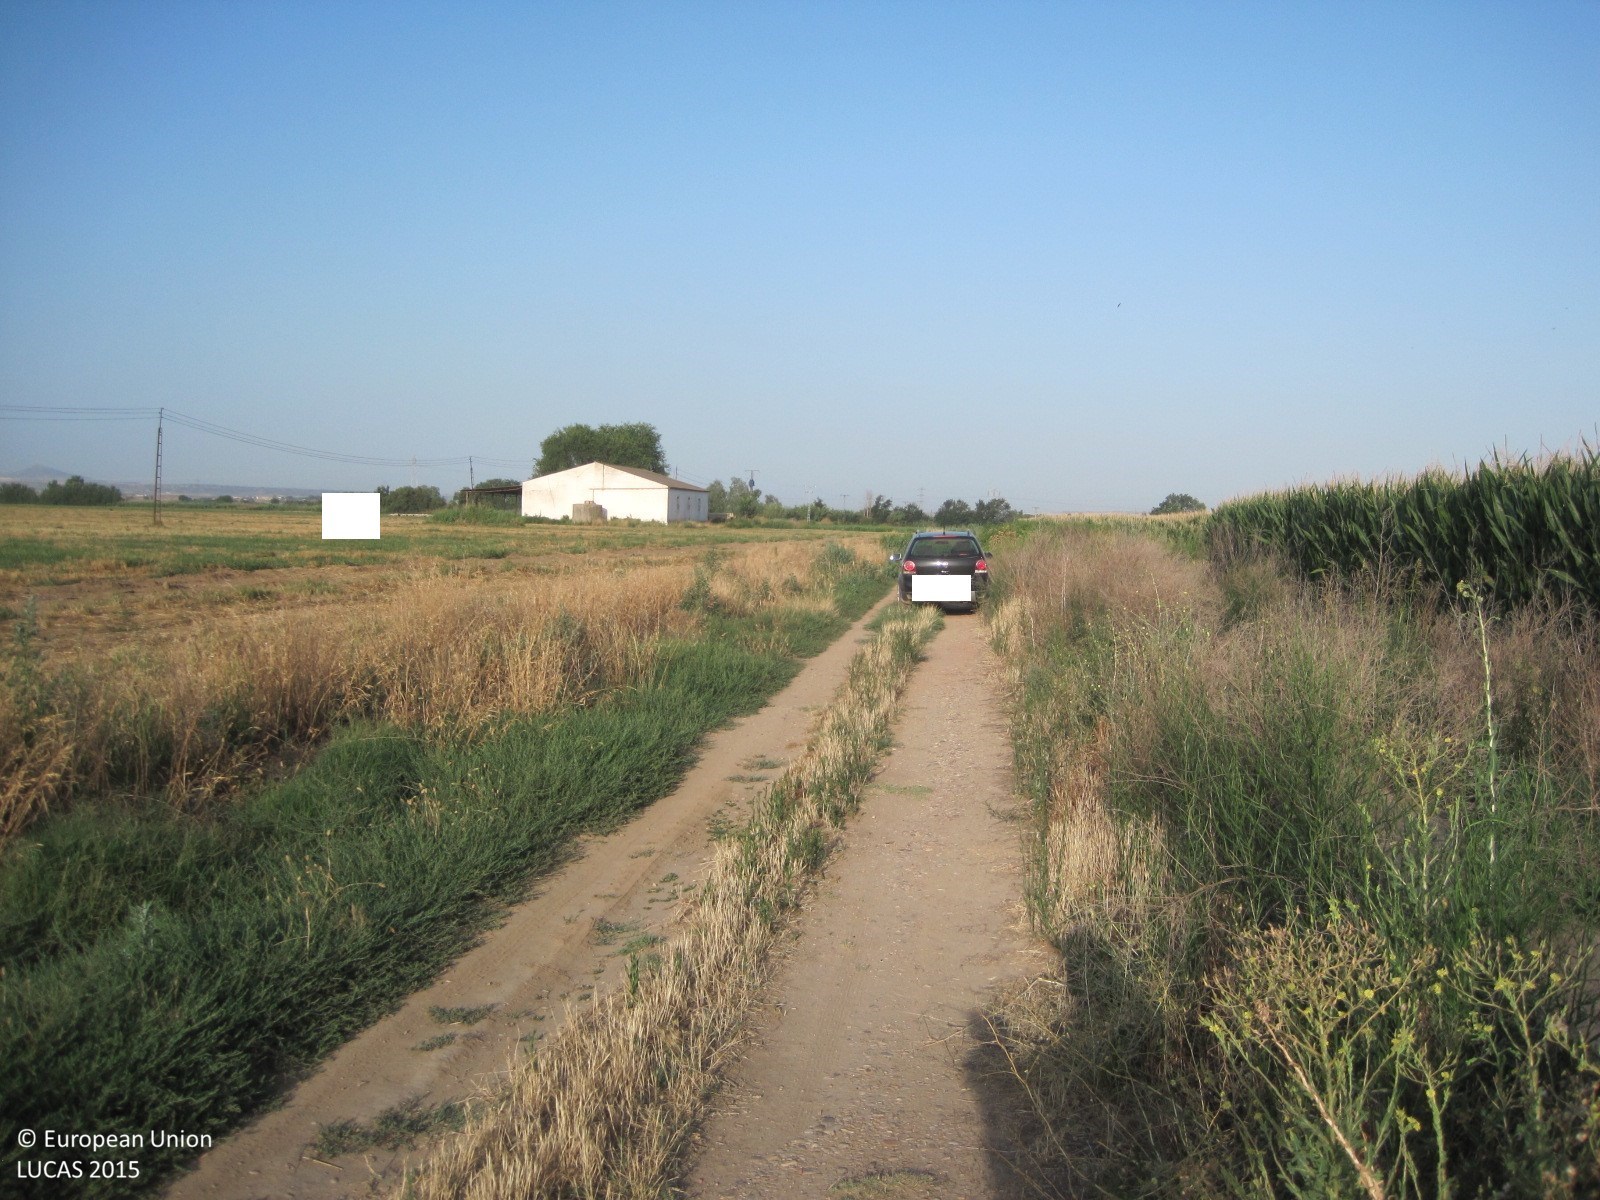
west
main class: Cropland
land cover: Maize
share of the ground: > 75 %
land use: Agriculture (excluding fallow land and kitchen gardens)
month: July
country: ES
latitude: 39.9422
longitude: -3.8312
